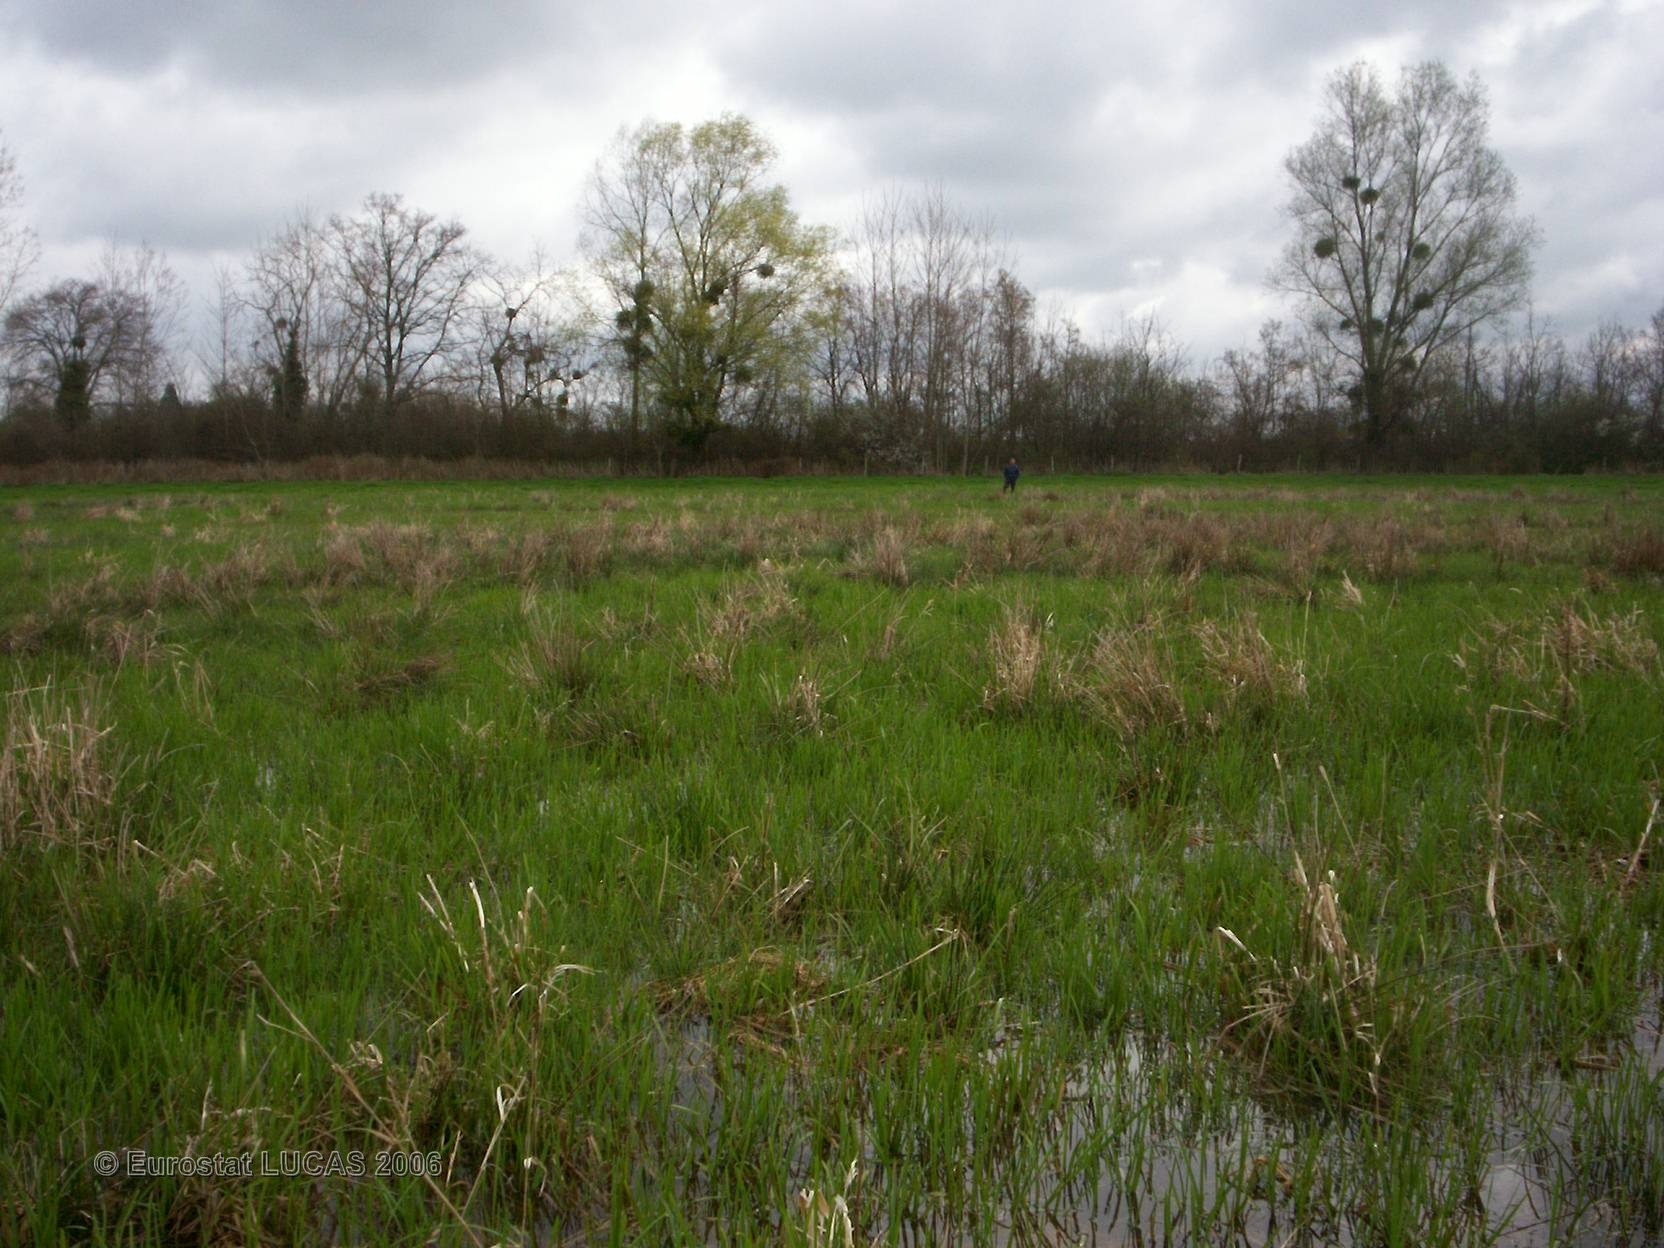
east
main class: Grassland
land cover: Grassland without tree/shrub cover
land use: Agriculture (excluding fallow land and kitchen gardens)
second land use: Wetland
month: April
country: FR
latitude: 46.8127
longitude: 3.0637
